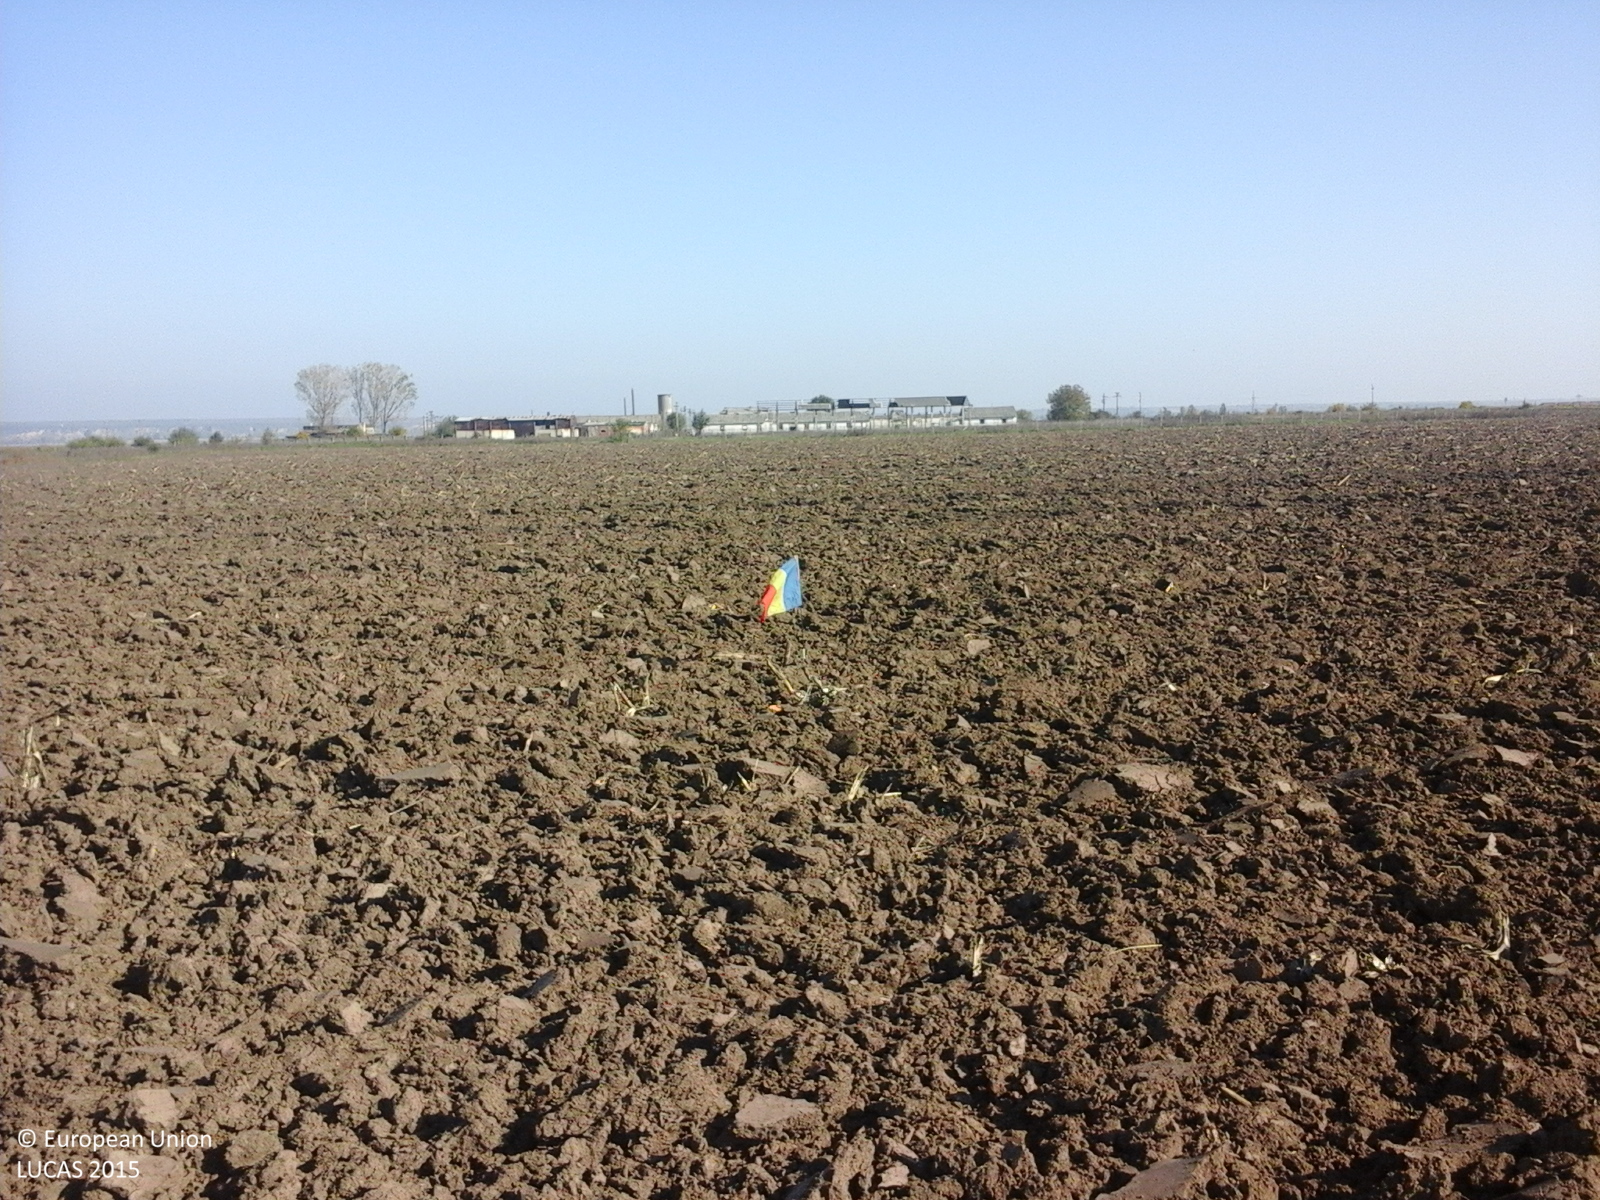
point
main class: Cropland
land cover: Maize
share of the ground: < 10 %
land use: Agriculture (excluding fallow land and kitchen gardens)
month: October
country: RO
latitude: 45.8835
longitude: 27.1957
